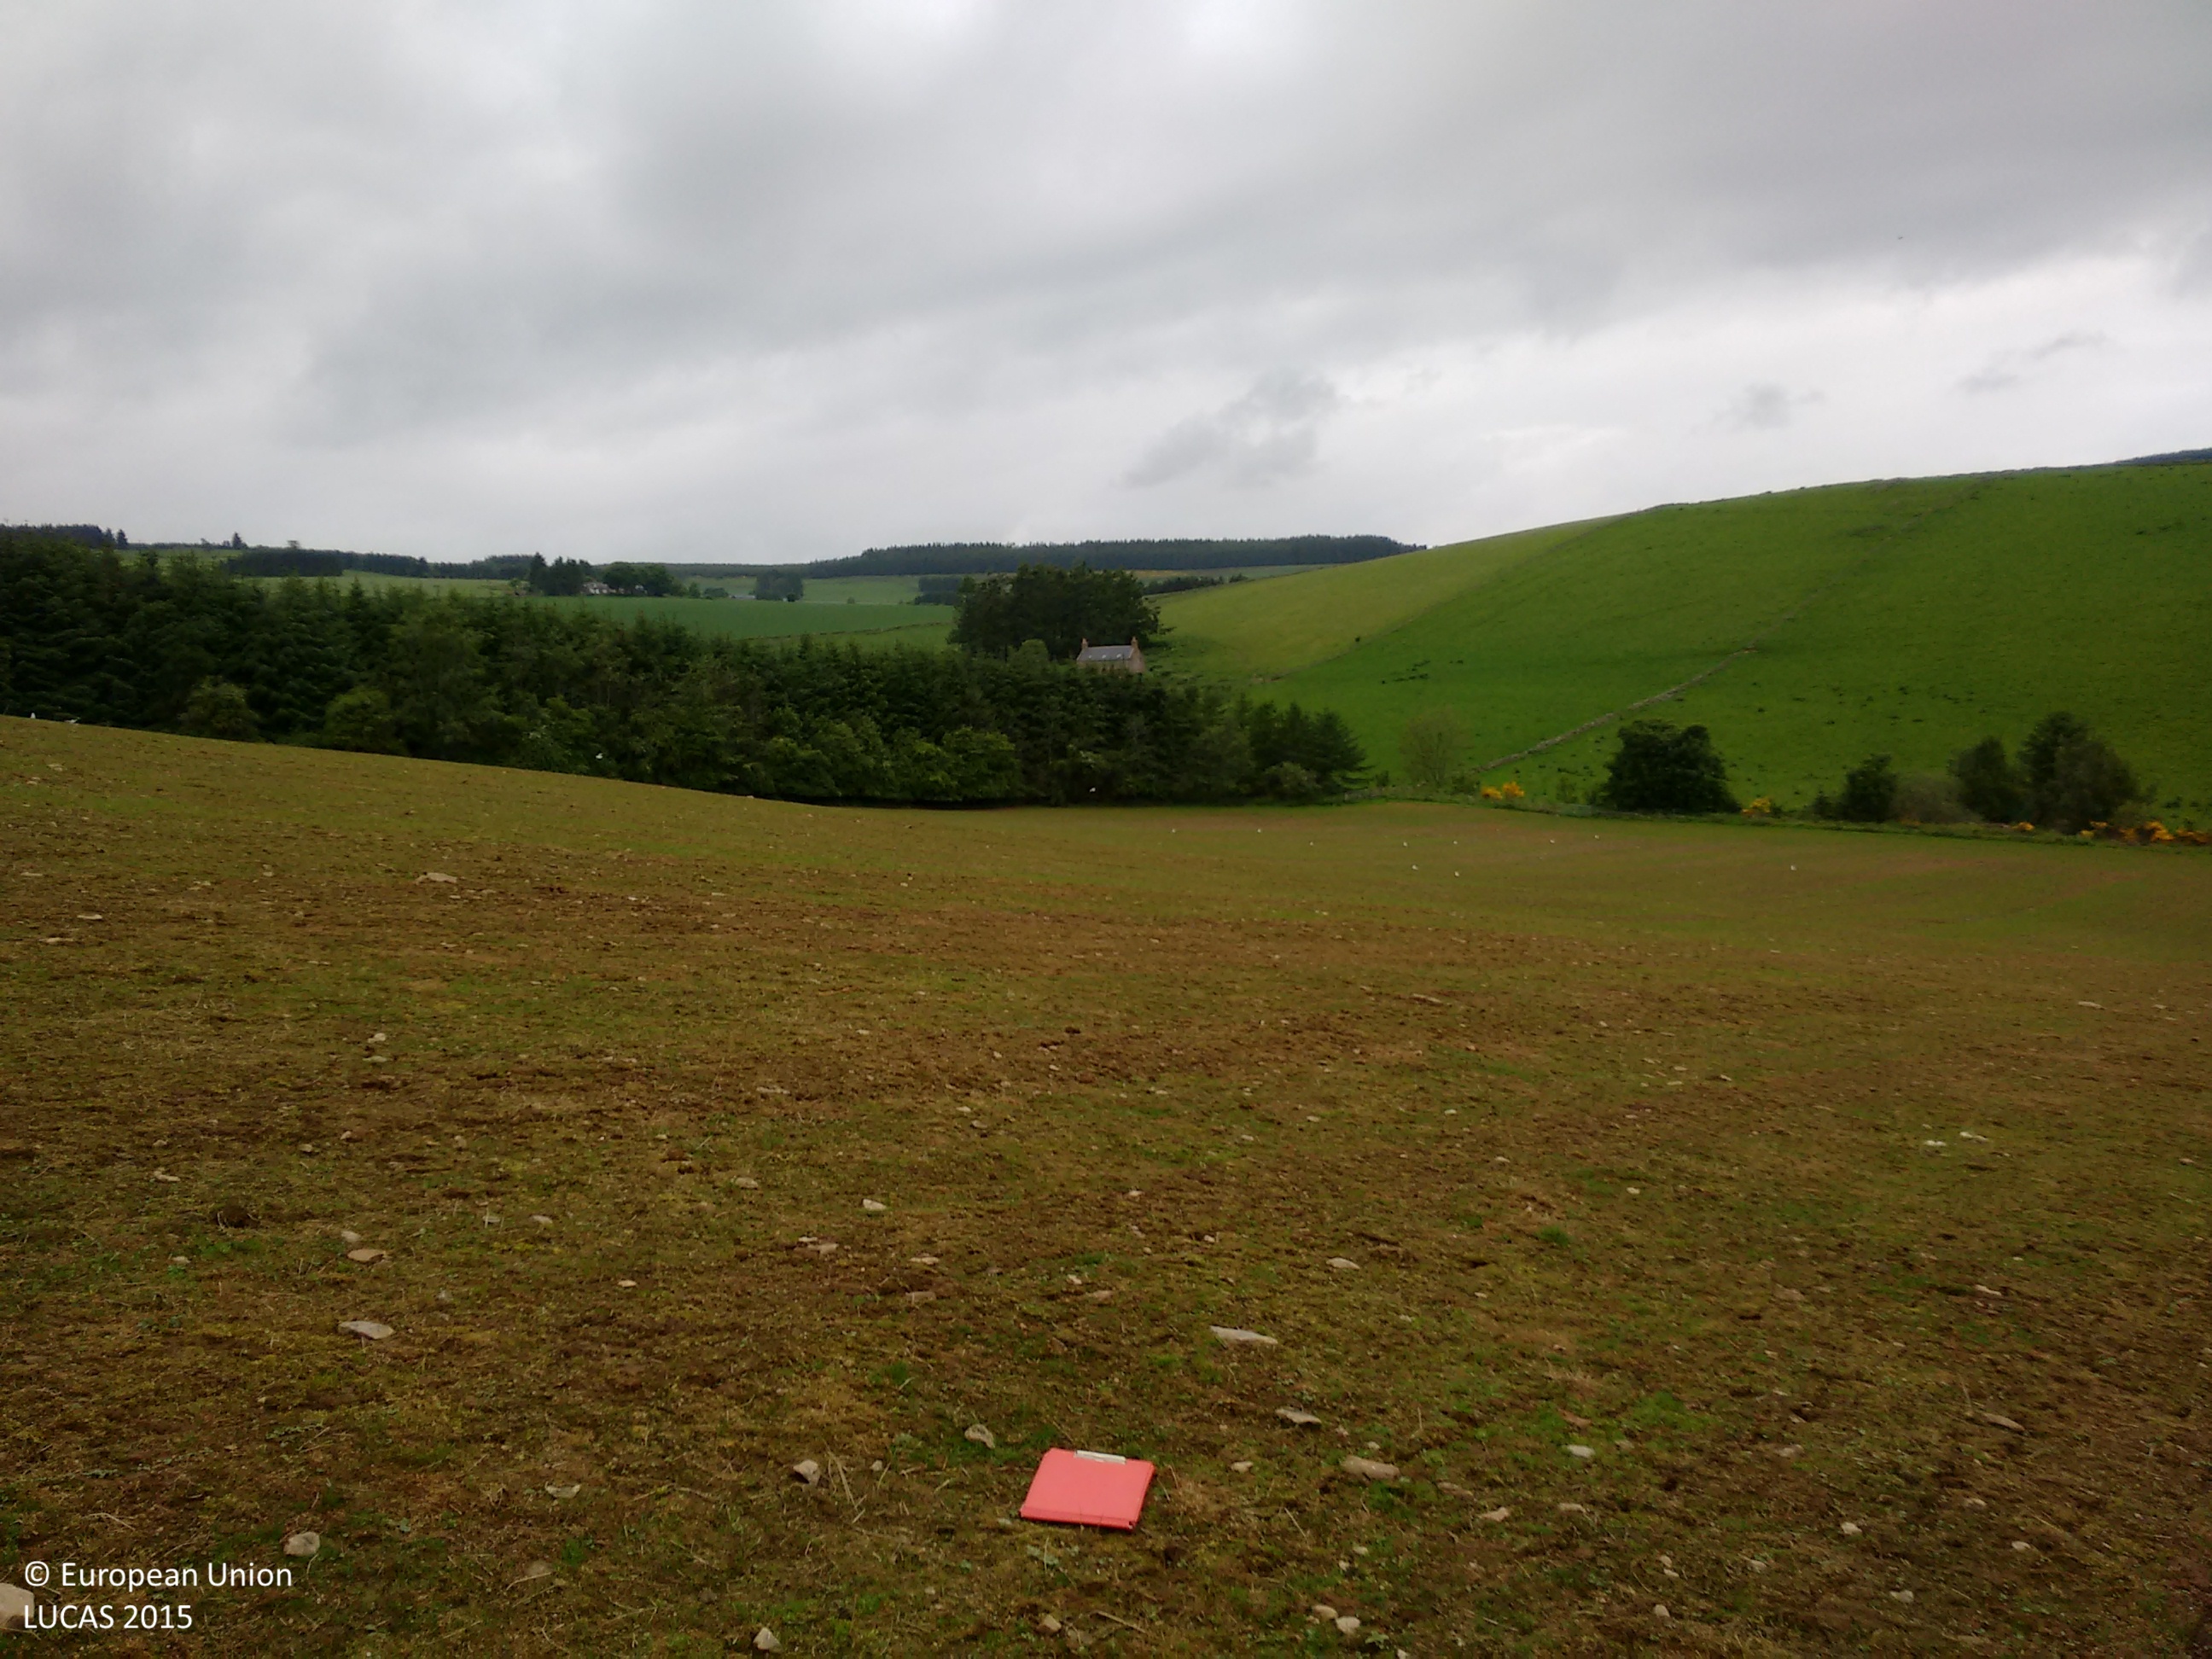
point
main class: Grassland
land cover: Grassland without tree/shrub cover
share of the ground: 25 - 50 %
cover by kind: herbaceous plants 60 %, unconsolidated bare surface 40 %
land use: Agriculture (excluding fallow land and kitchen gardens)
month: June
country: GB
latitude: 57.1831
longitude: -2.8150
